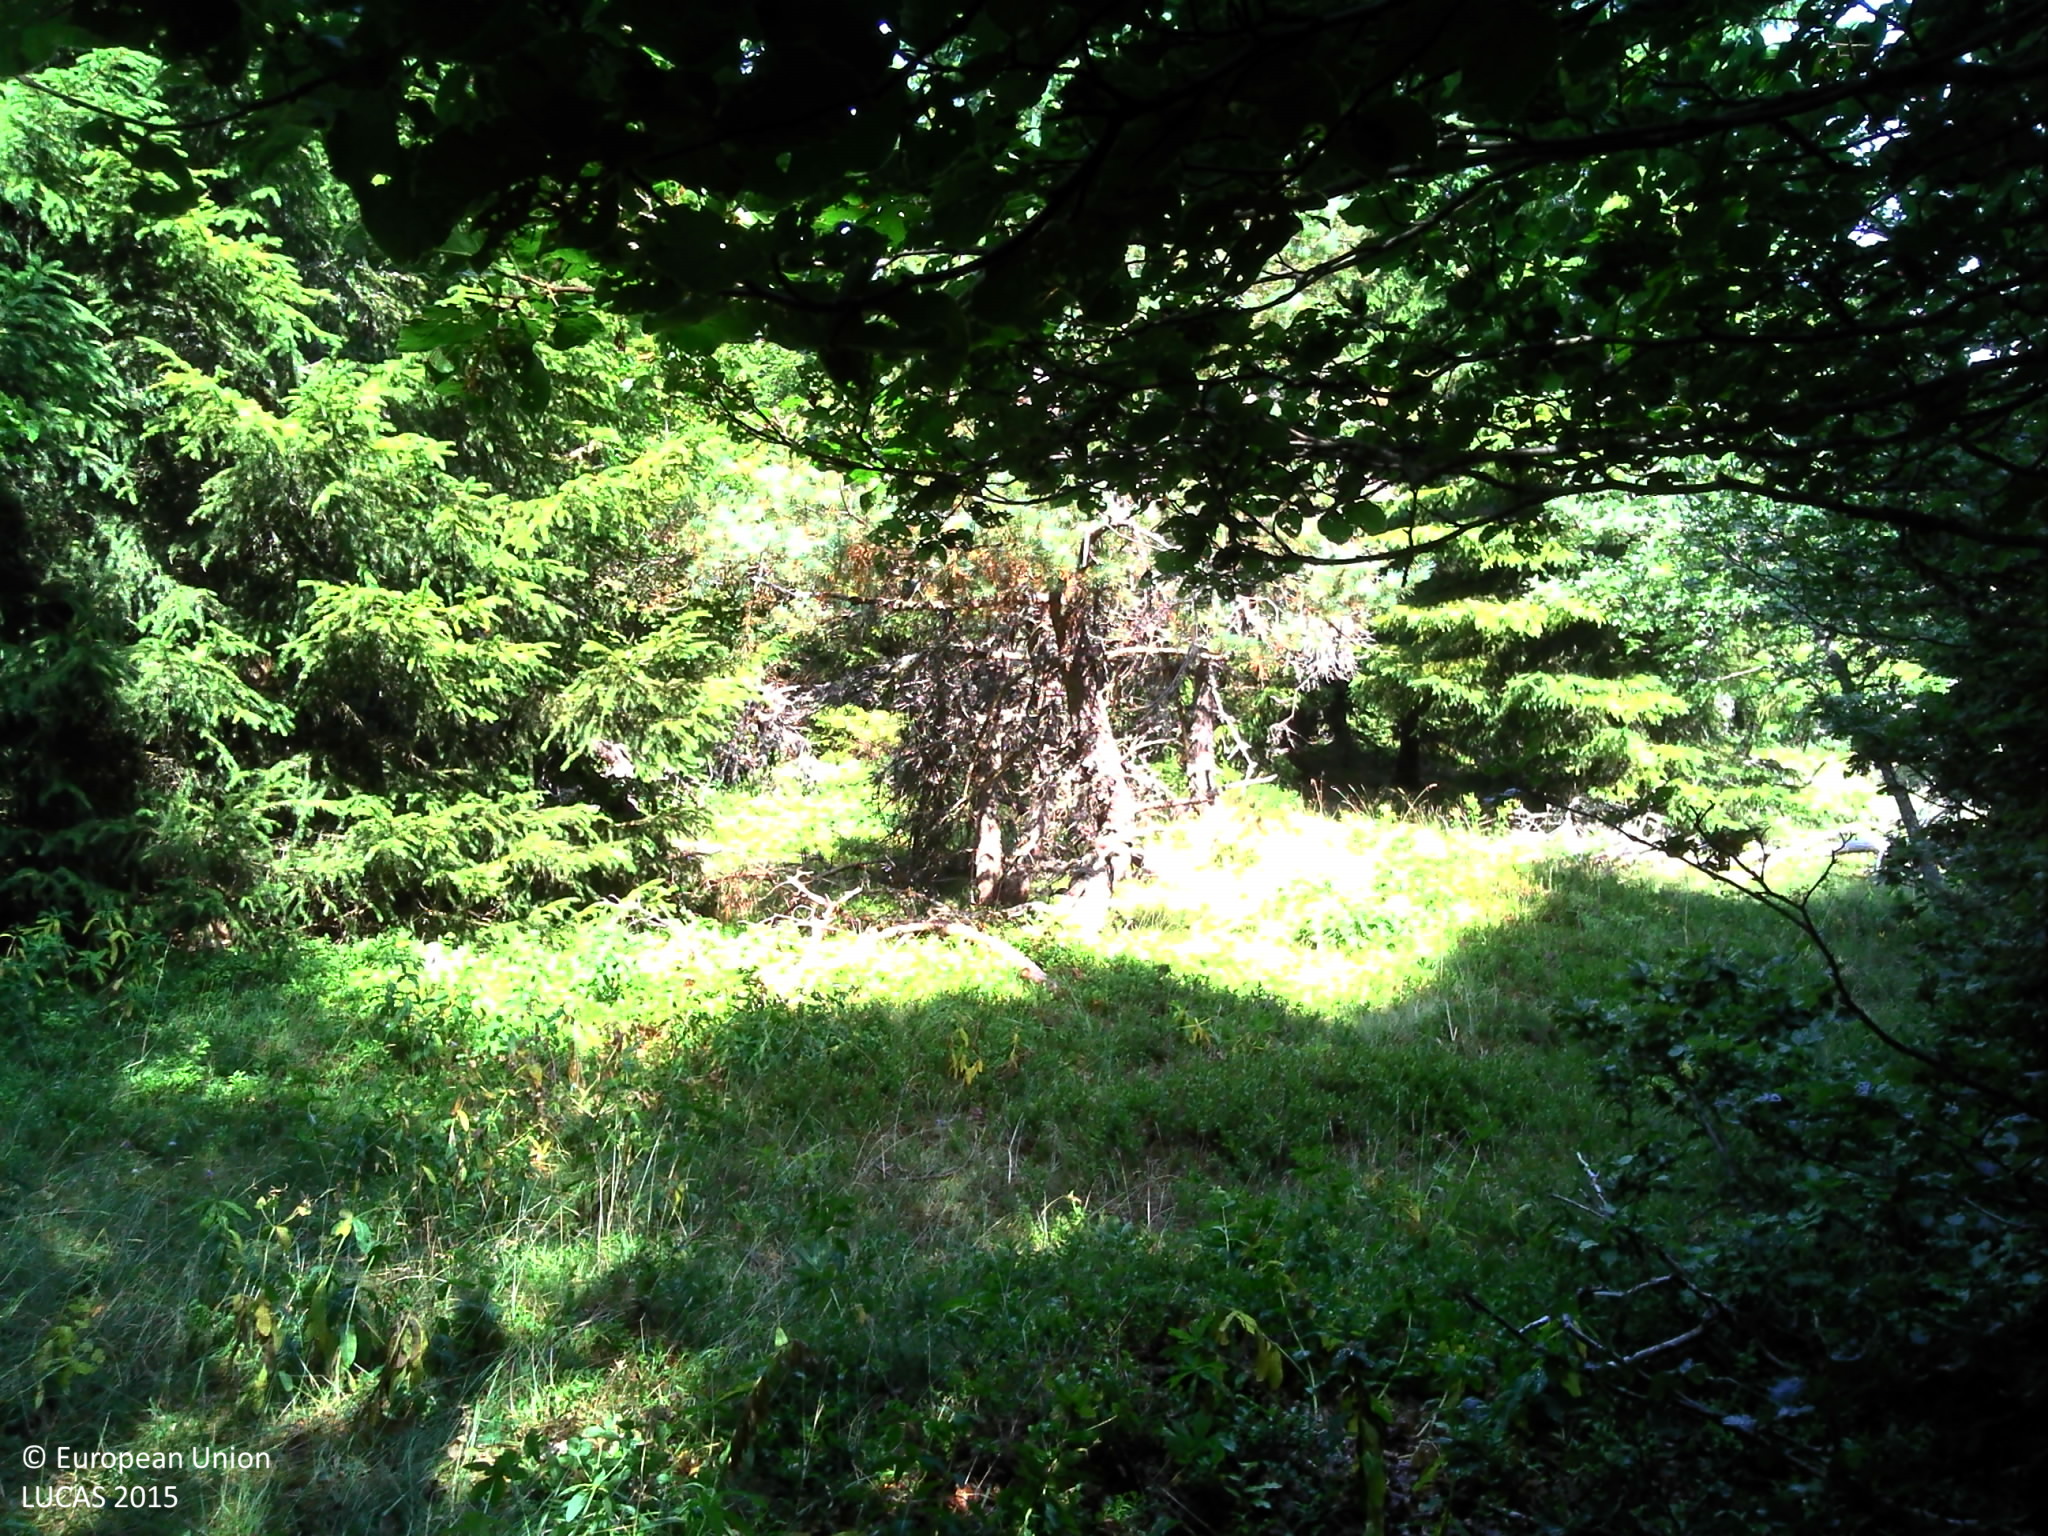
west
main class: Woodland
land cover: Spruce dominated mixed woodland
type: mountainous beech forest
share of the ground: > 75 %
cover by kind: broadleaved forest trees 55 %, coniferous forest trees 20 %, herbaceous plants 10 %, lichens and mosses 10 %, shrubs 5 %
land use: Forestry
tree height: > 5 m
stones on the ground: < 10 %
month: July
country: FR
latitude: 44.6880
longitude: 2.9246
